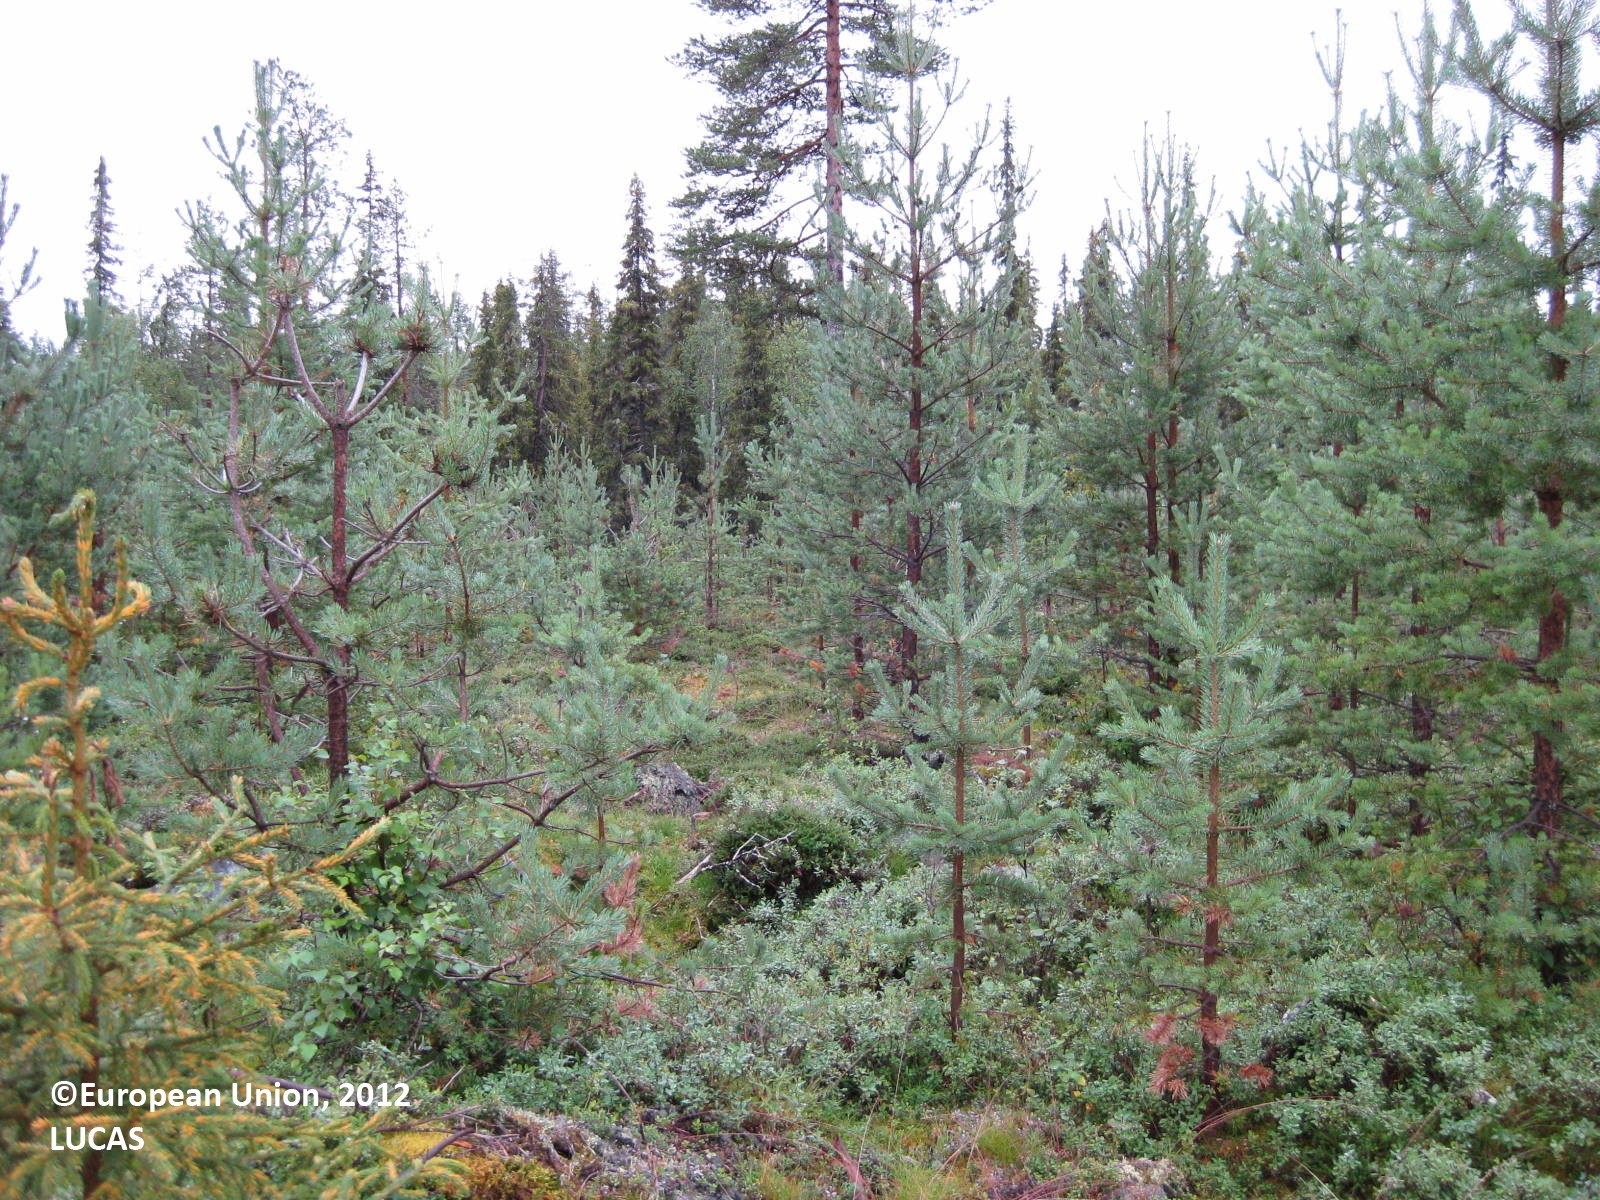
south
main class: Woodland
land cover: Pine dominated coniferous woodland
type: boreal forest
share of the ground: 50 - 75 %
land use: Forestry
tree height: < 5 m
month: August
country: FI
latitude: 65.8325
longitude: 28.2057
